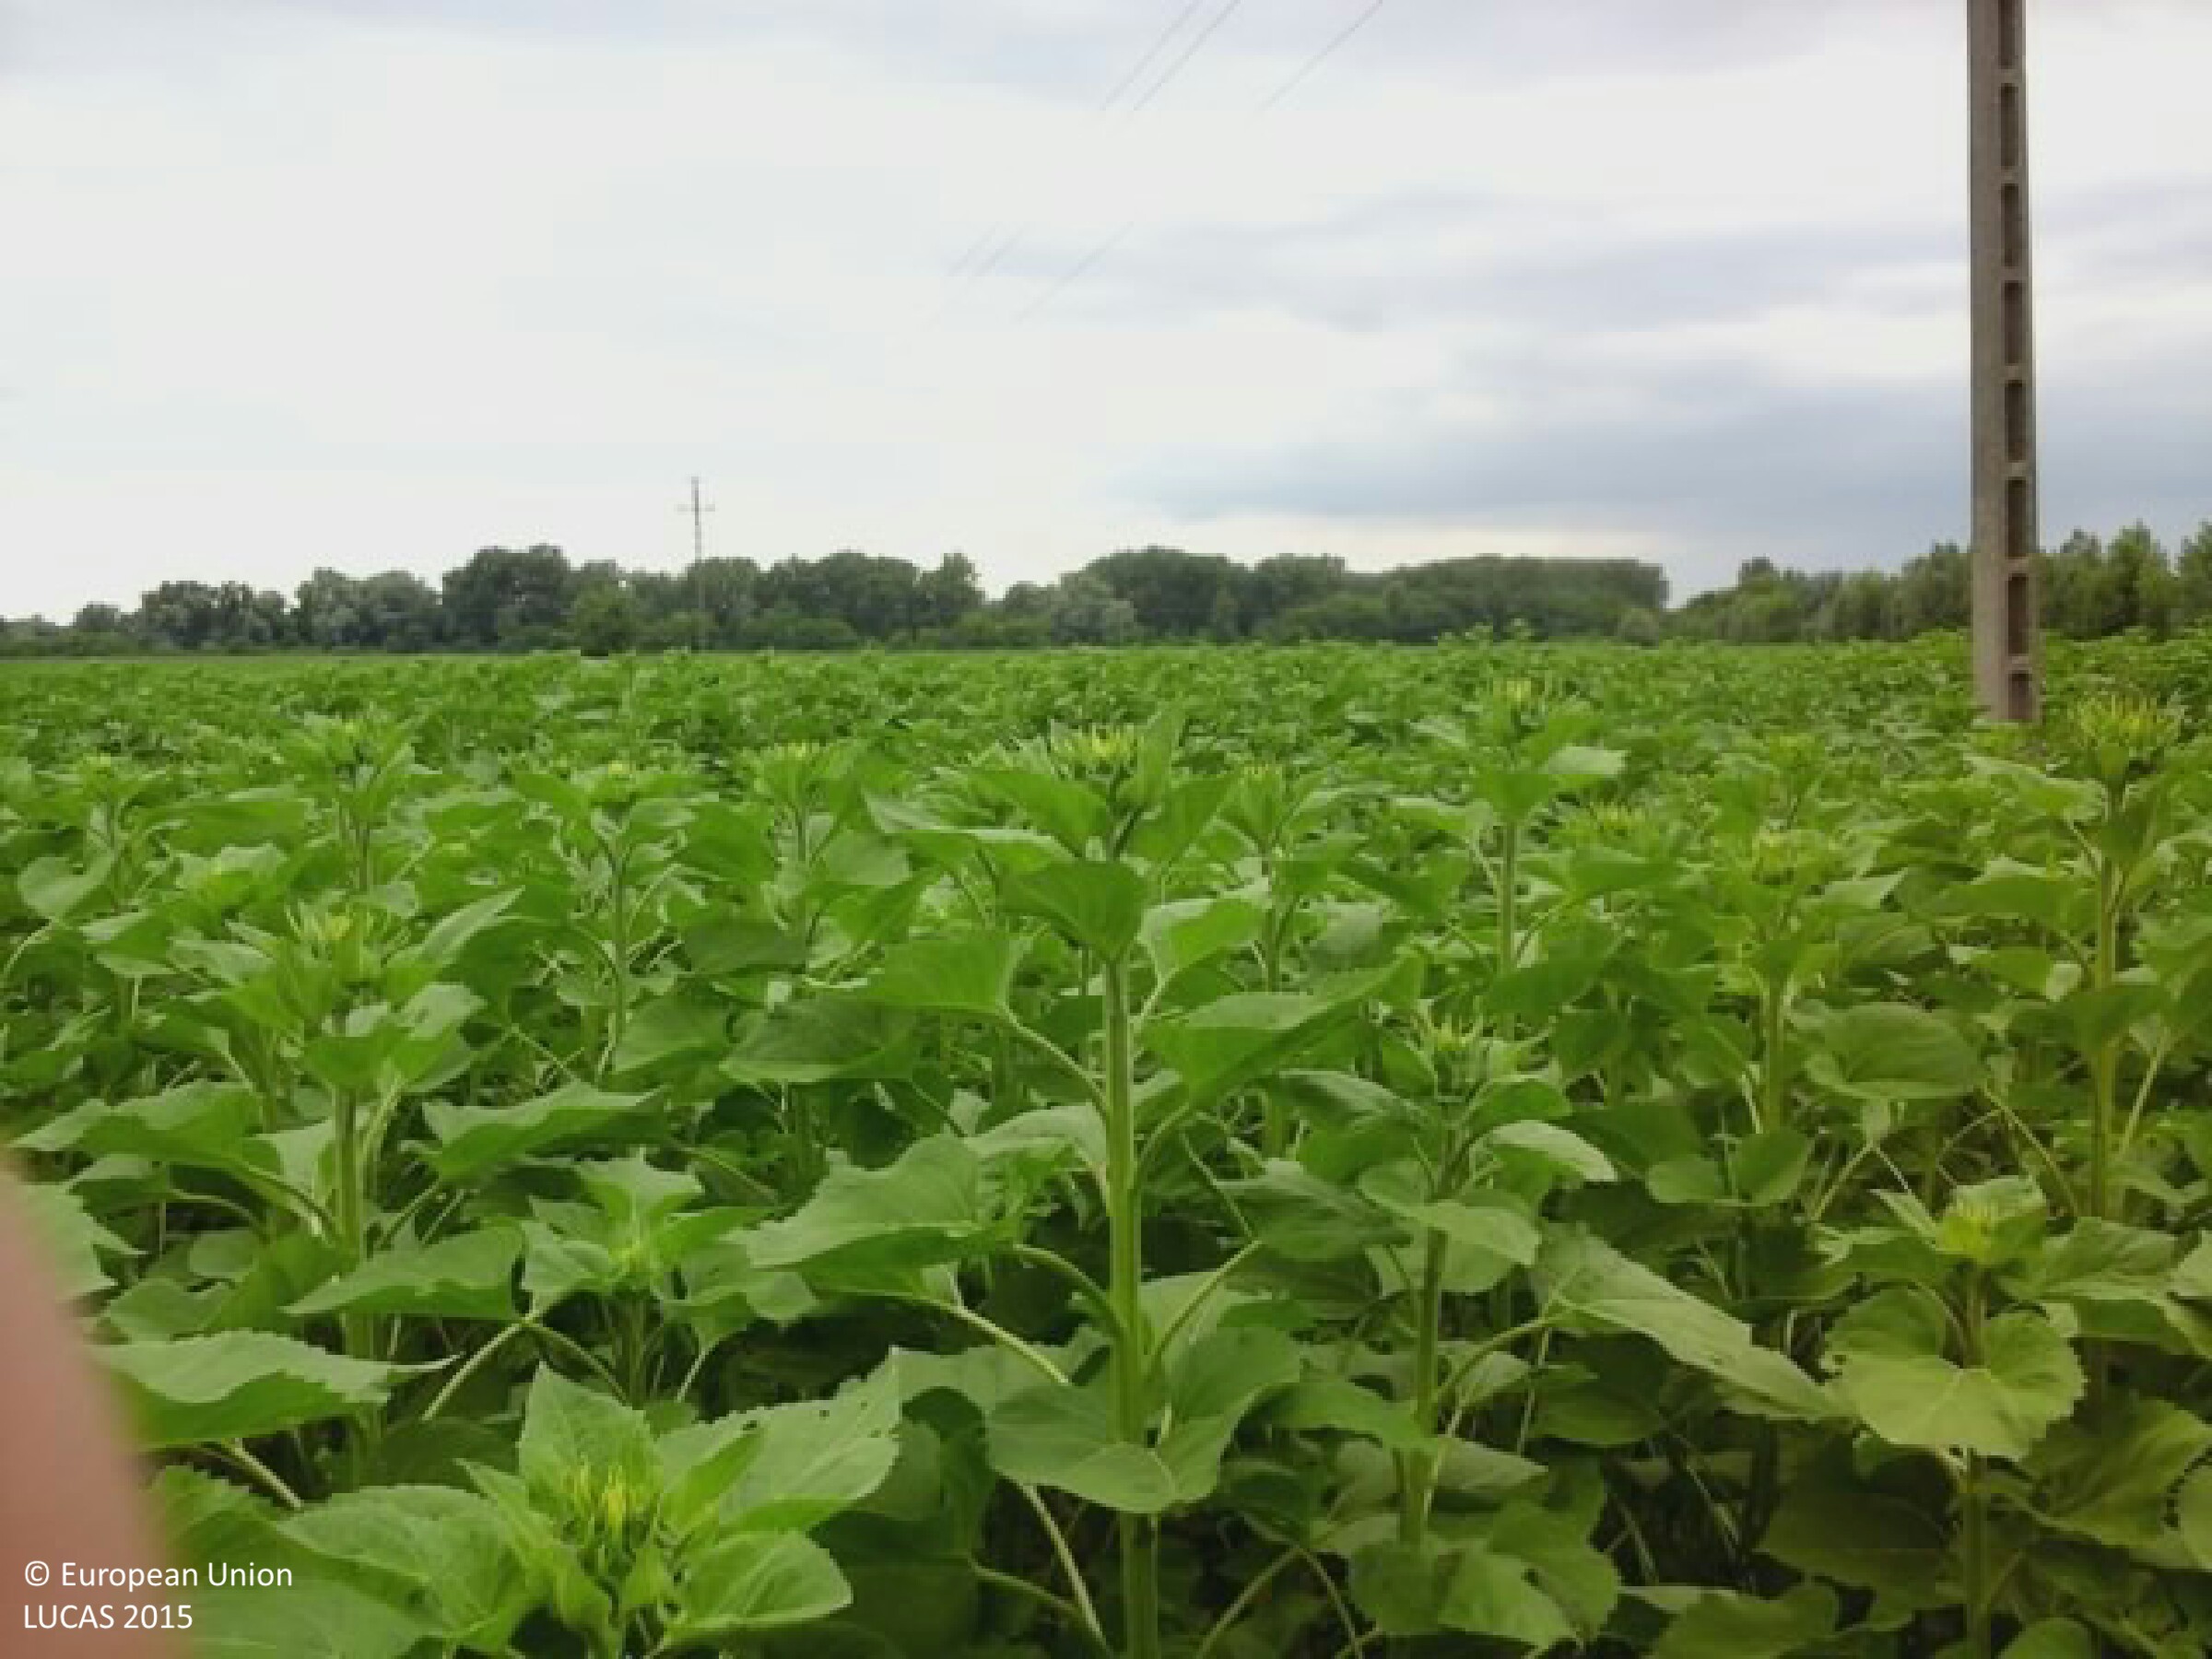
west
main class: Cropland
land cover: Sunflower
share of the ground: > 75 %
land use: Agriculture (excluding fallow land and kitchen gardens)
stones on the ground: < 10 %
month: June
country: HU
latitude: 46.1758
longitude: 18.9369
